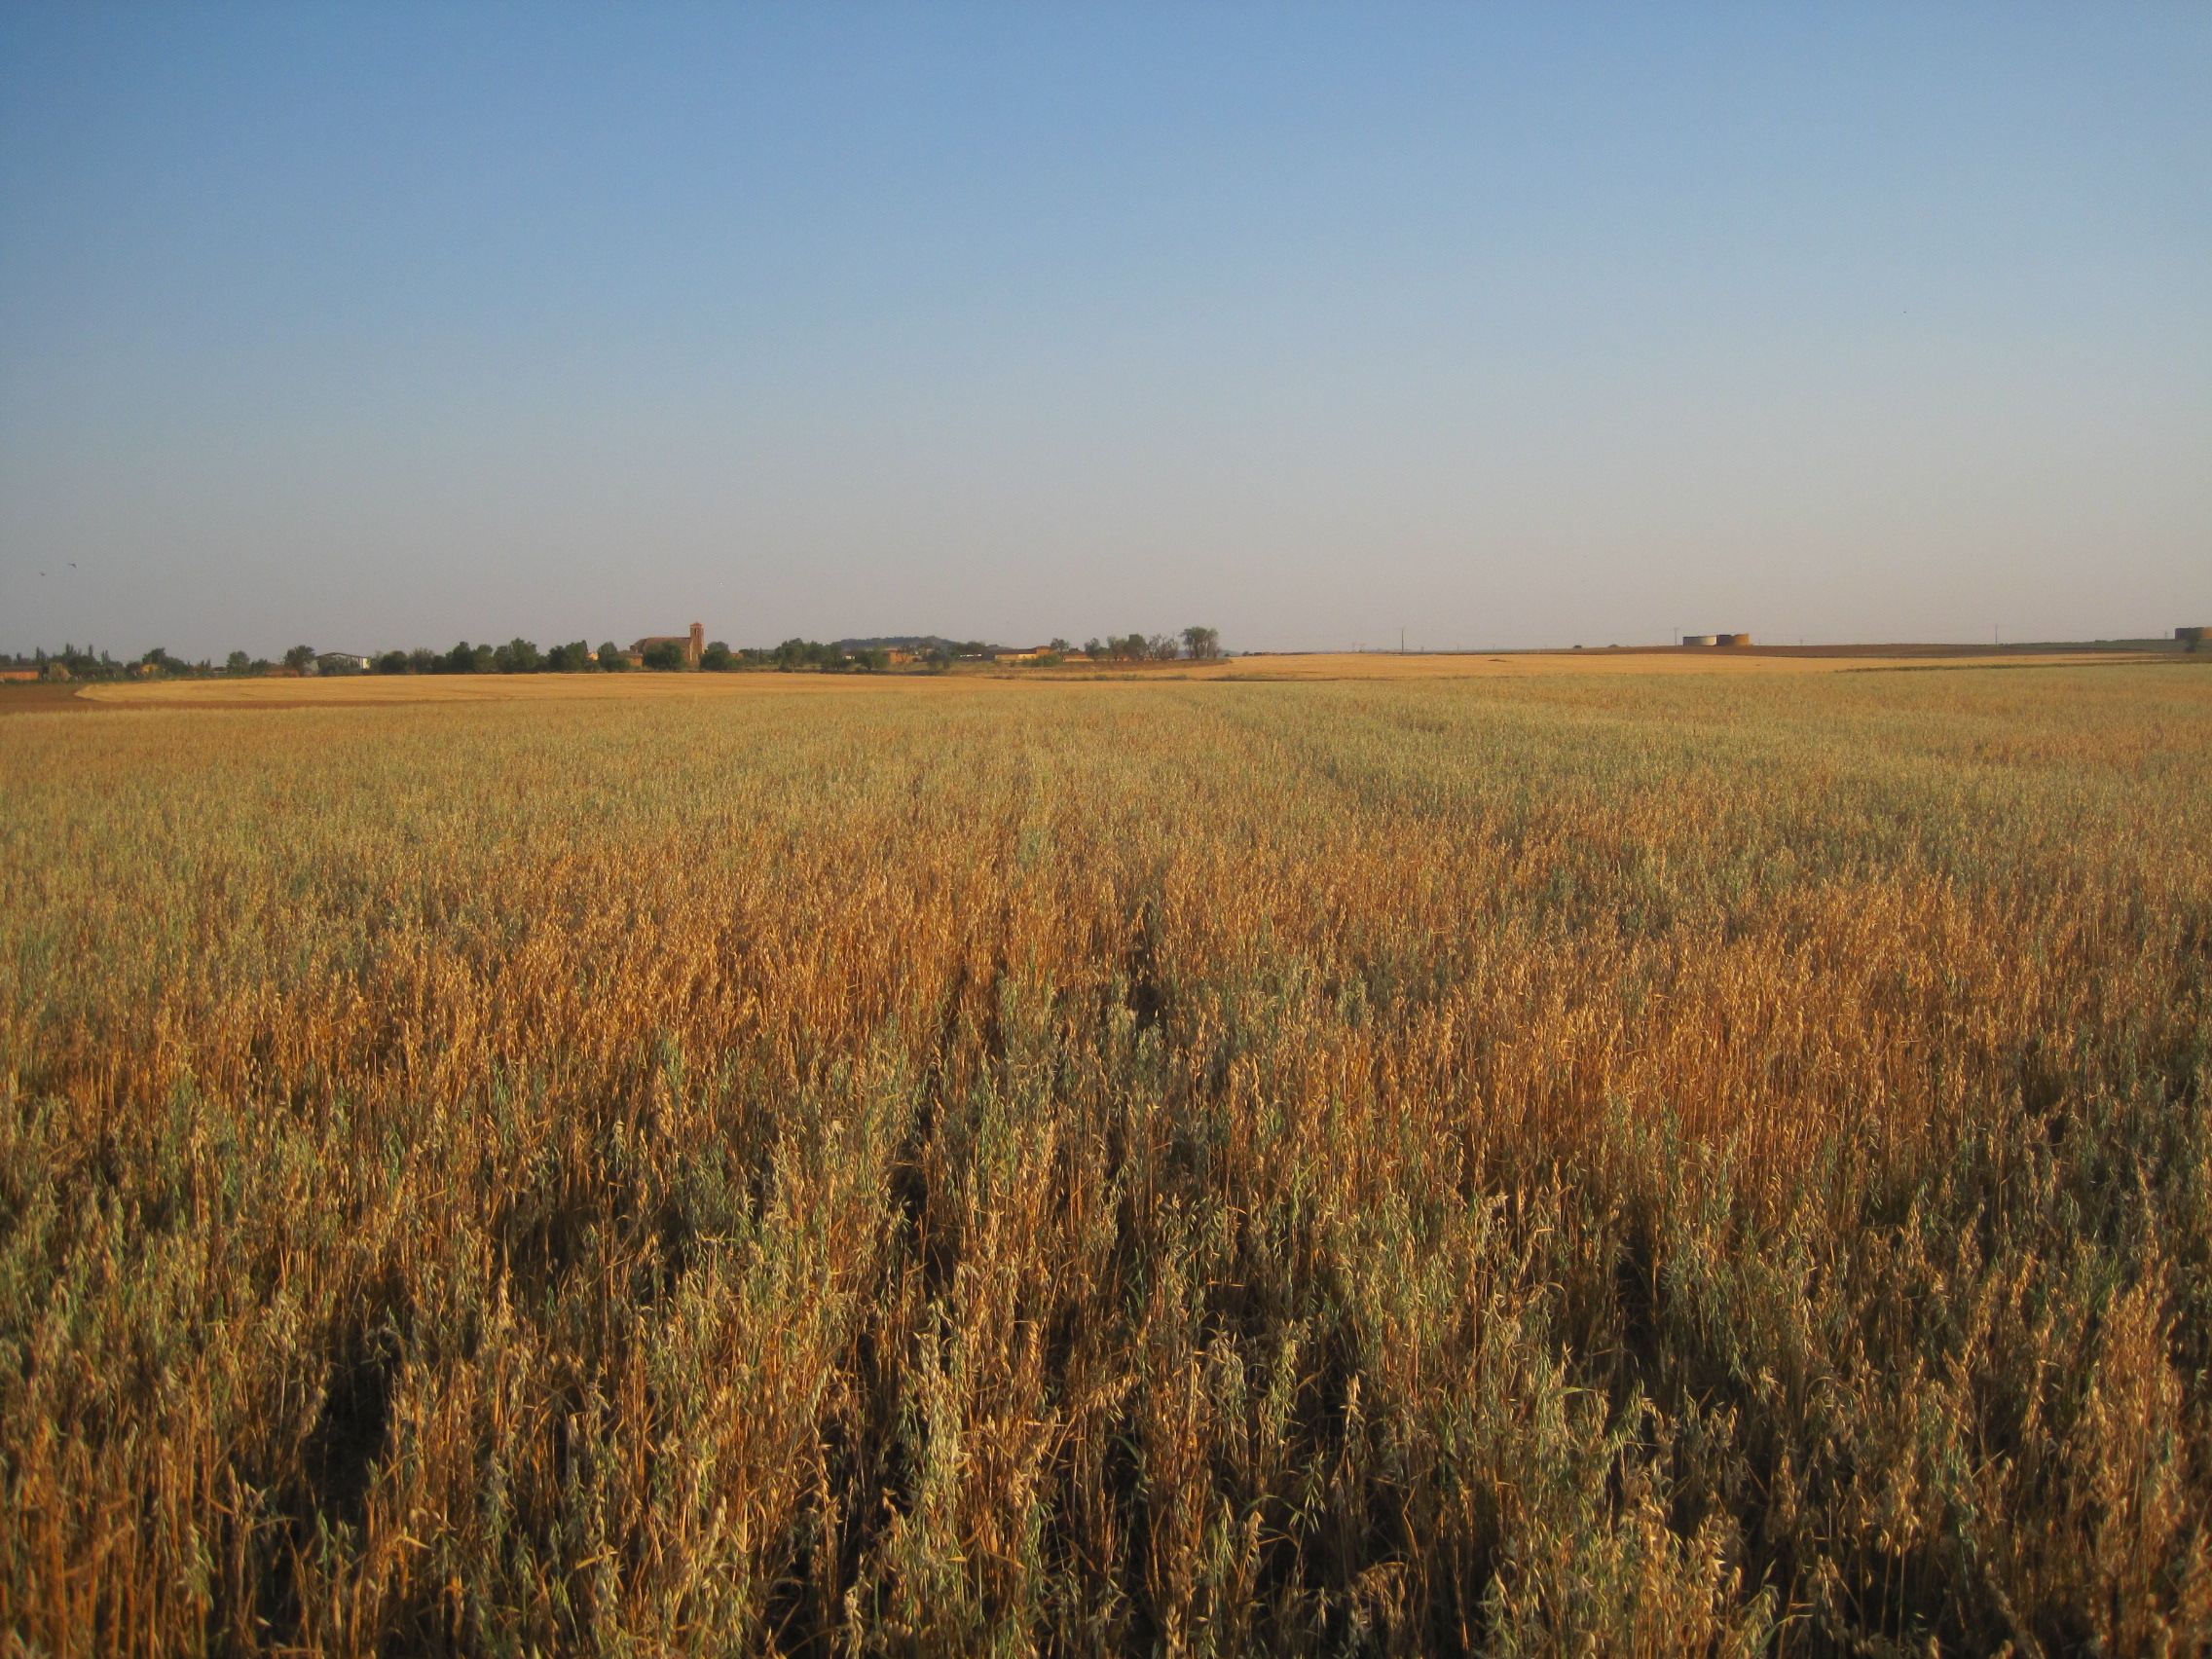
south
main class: Cropland
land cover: Oats
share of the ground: > 75 %
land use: Agriculture (excluding fallow land and kitchen gardens)
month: July
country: ES
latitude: 41.8696
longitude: -5.1765
